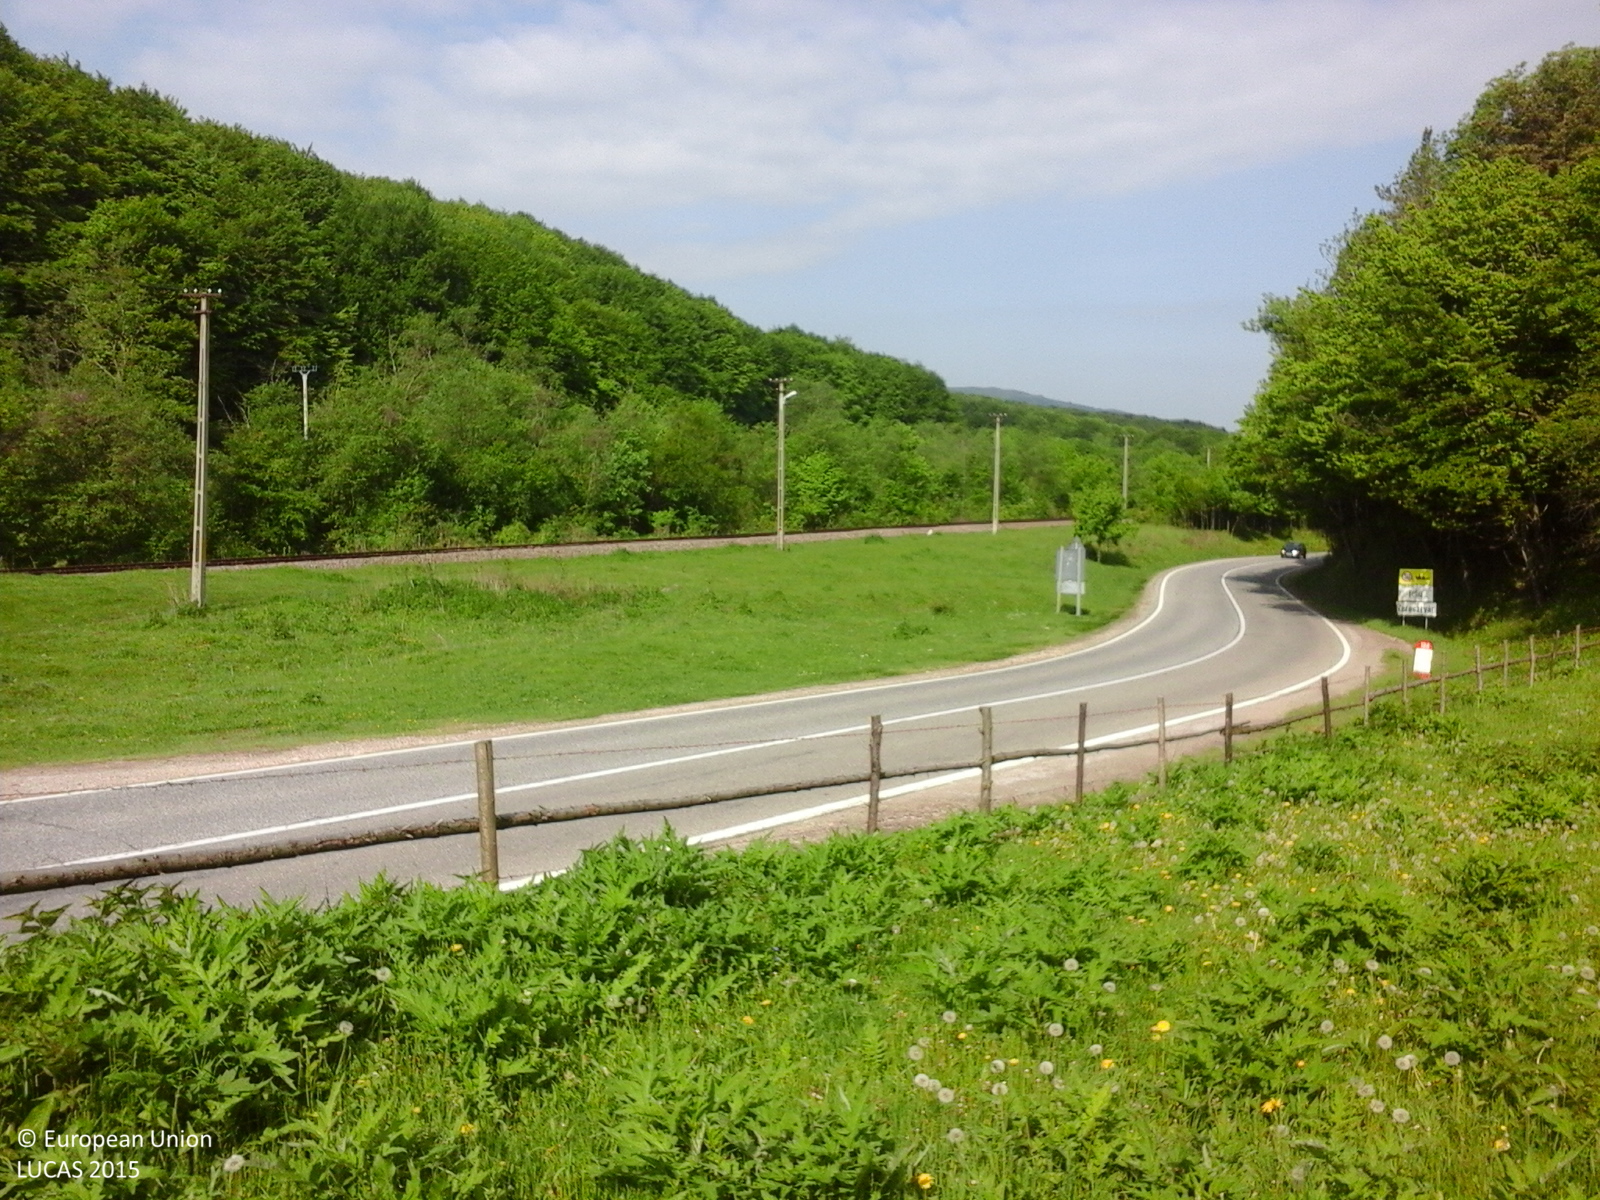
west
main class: Grassland
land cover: Grassland without tree/shrub cover
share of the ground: > 75 %
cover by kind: herbaceous plants 100 %
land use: Agriculture (excluding fallow land and kitchen gardens)
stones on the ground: < 10 %
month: May
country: RO
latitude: 45.6778
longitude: 25.9423
